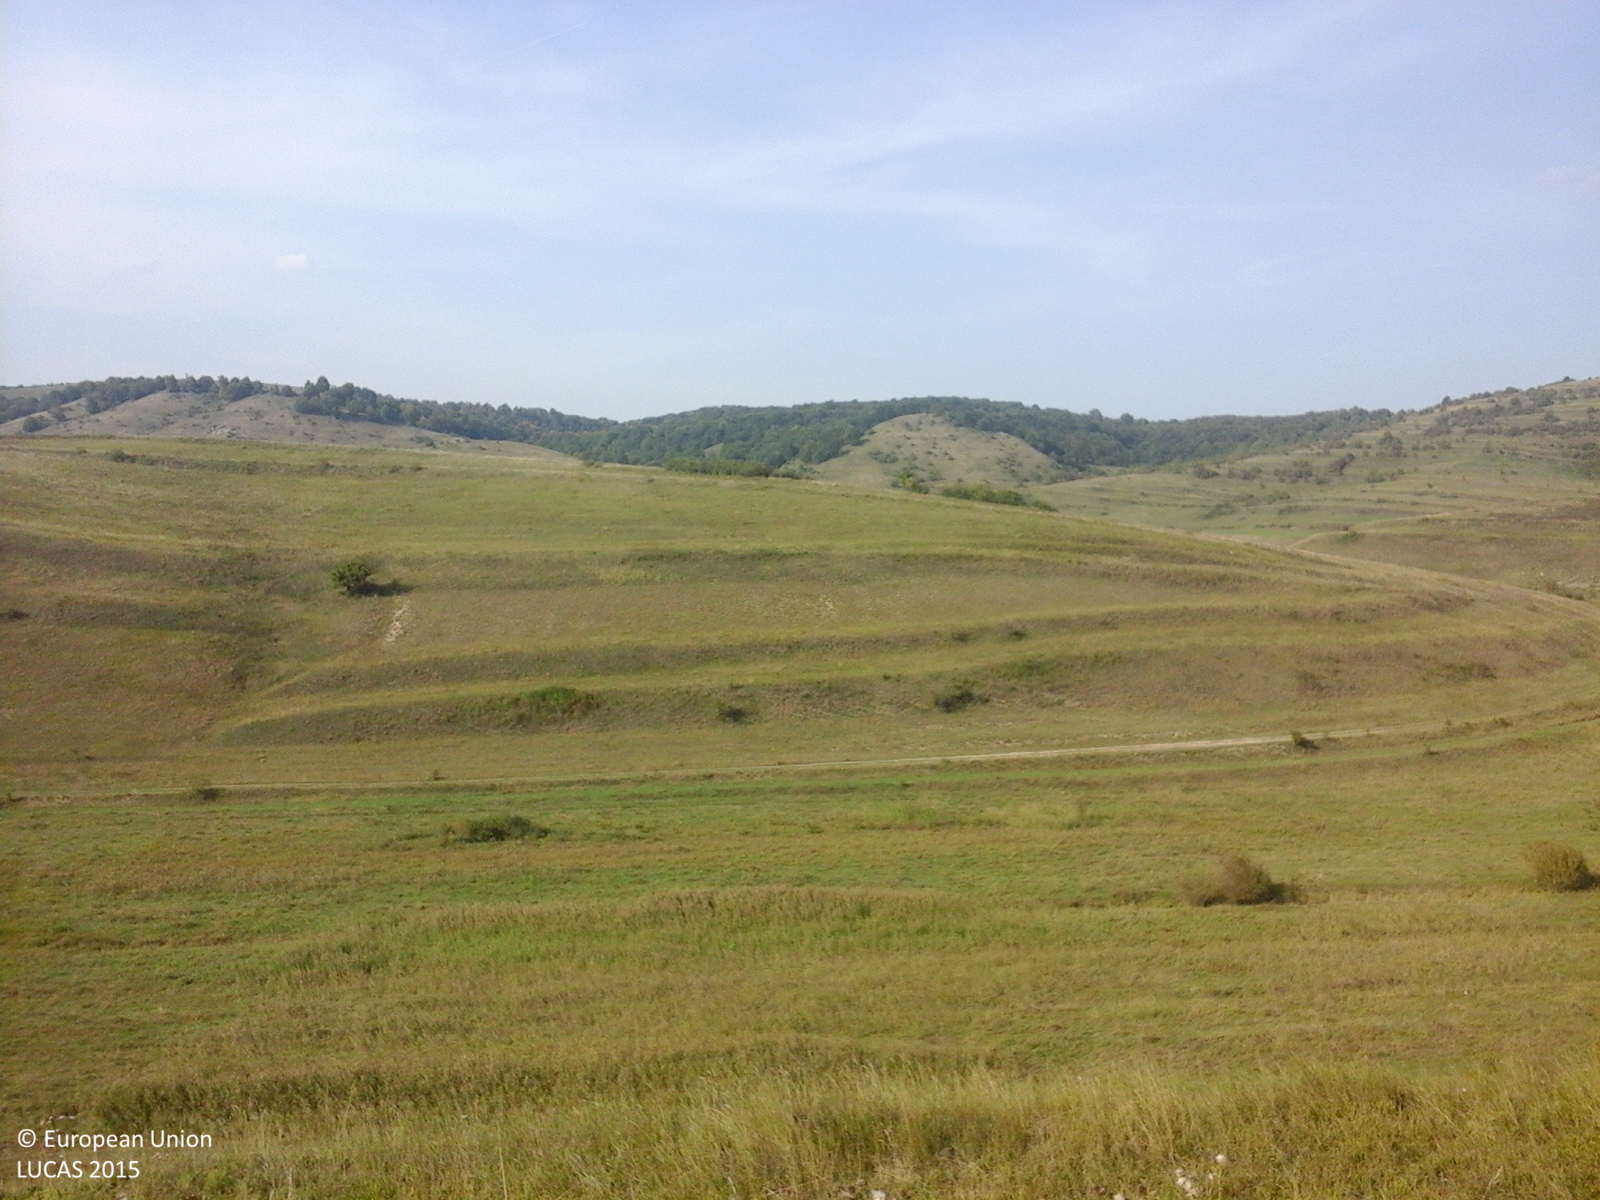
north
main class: Grassland
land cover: Grassland without tree/shrub cover
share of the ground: > 75 %
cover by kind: herbaceous plants 100 %
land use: Agriculture (excluding fallow land and kitchen gardens)
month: September
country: RO
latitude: 46.7919
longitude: 23.3108
